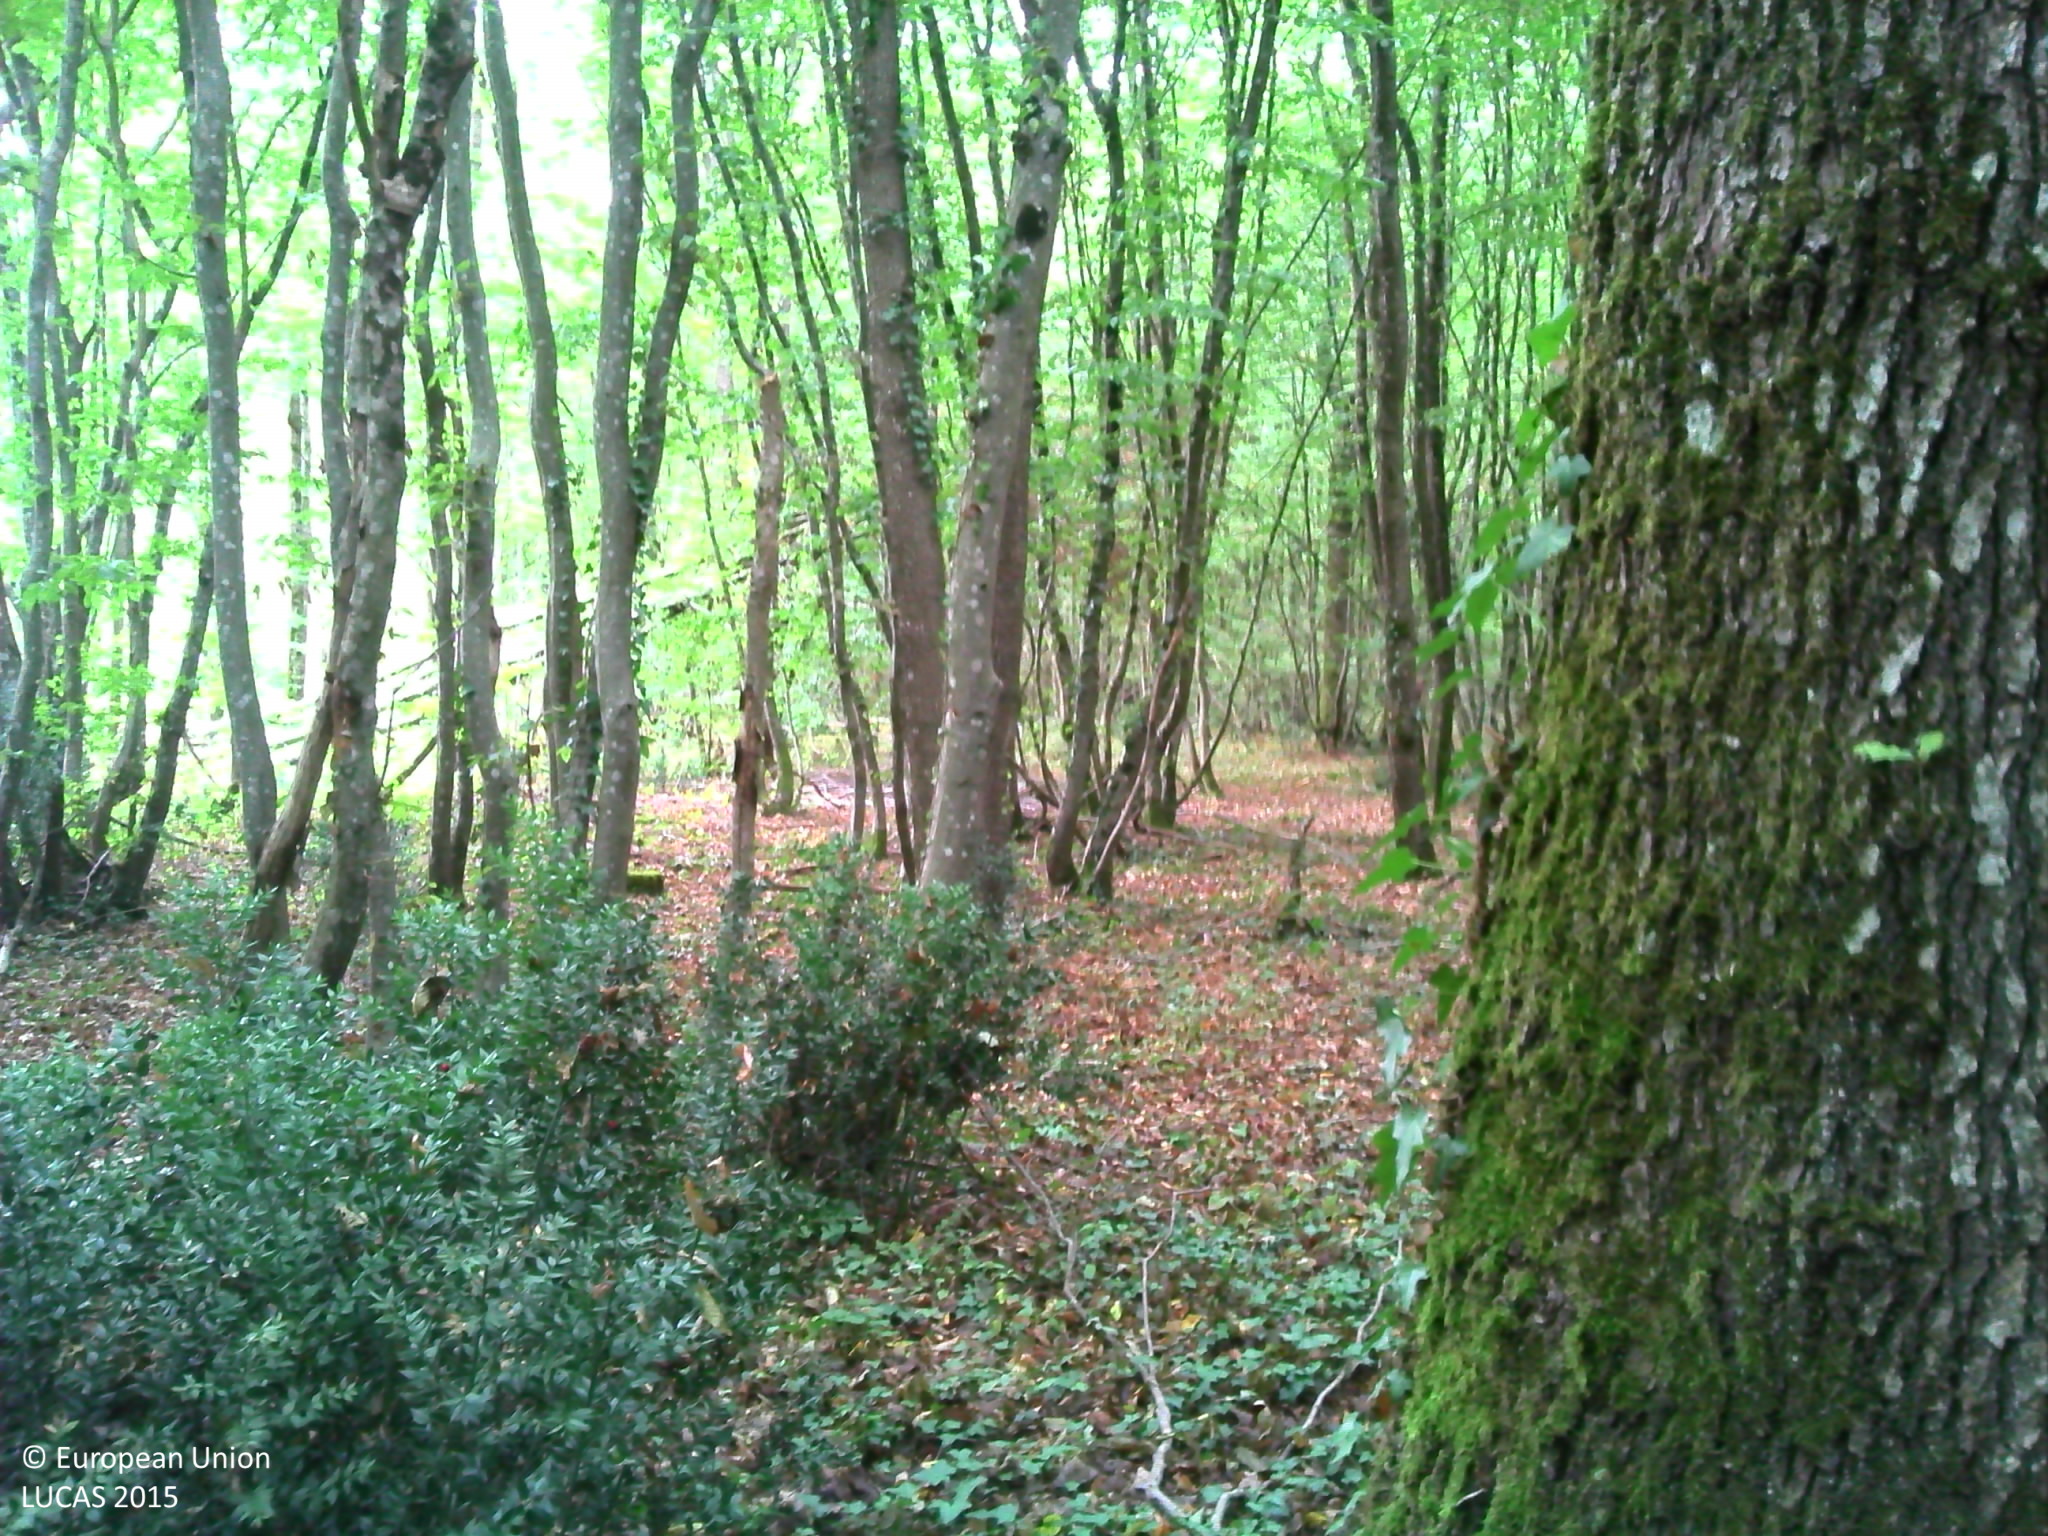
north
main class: Woodland
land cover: Broadleaved woodland
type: acidophilous oak and oak-birch forest
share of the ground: > 75 %
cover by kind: broadleaved forest trees 60 %, unconsolidated bare surface 30 %, herbaceous plants 10 %
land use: Forestry
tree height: > 5 m
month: August
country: FR
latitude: 48.1327
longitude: 2.8029
